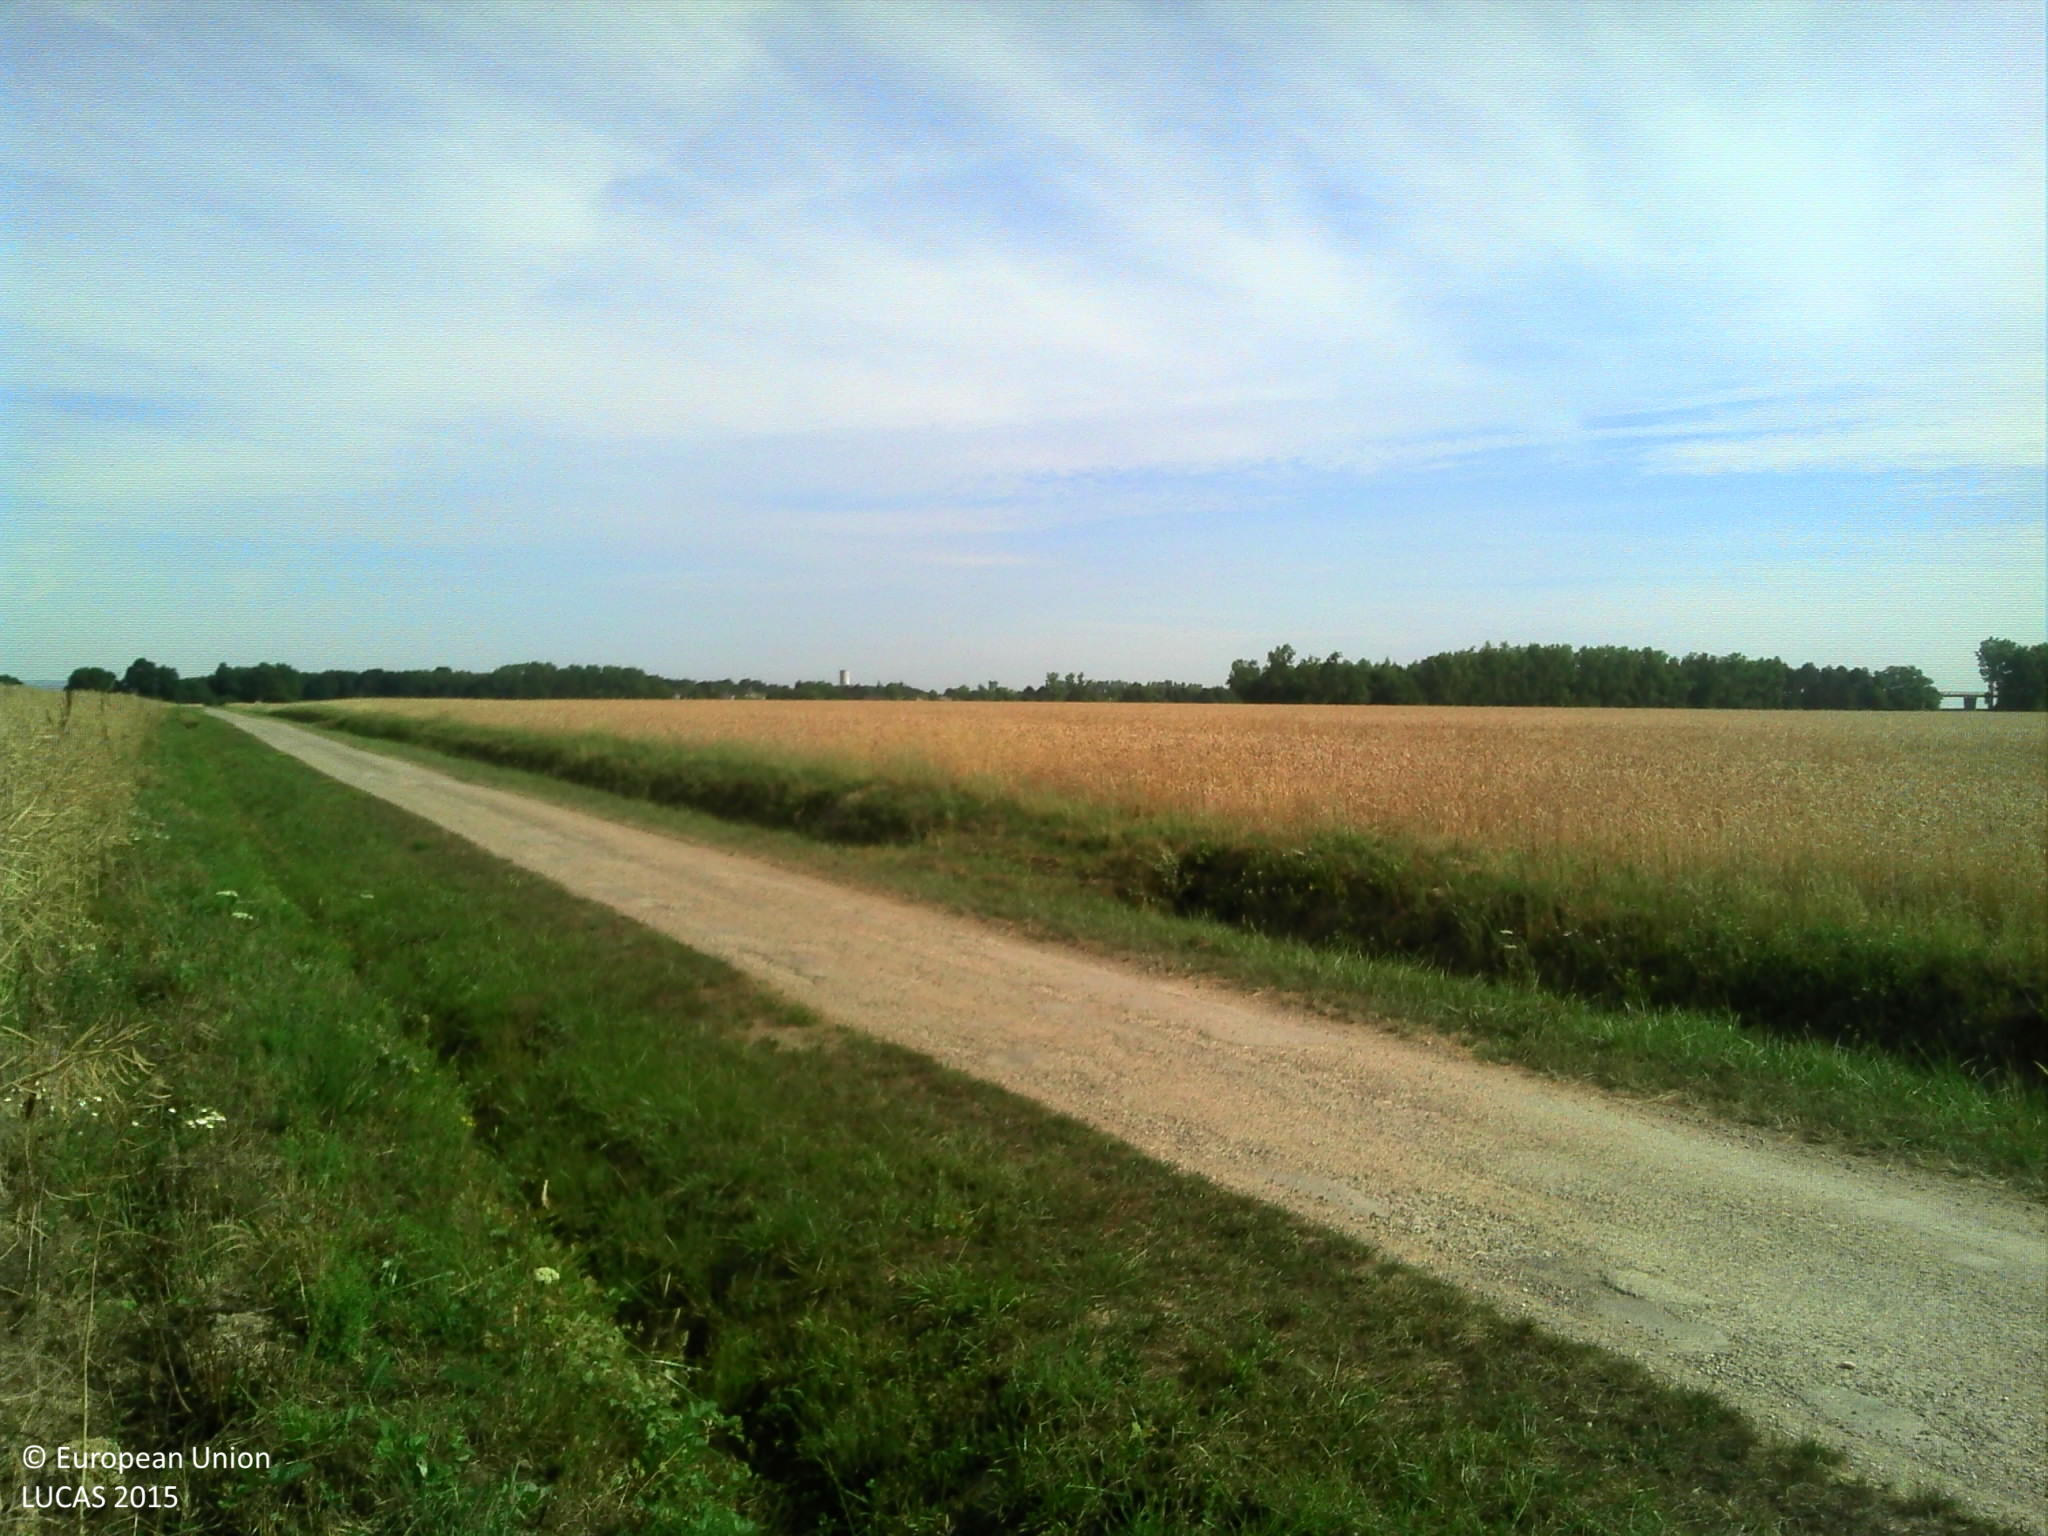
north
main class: Cropland
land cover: Rape and turnip rape
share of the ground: > 75 %
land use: Agriculture (excluding fallow land and kitchen gardens)
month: June
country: FR
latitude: 46.7136
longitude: 4.8342
